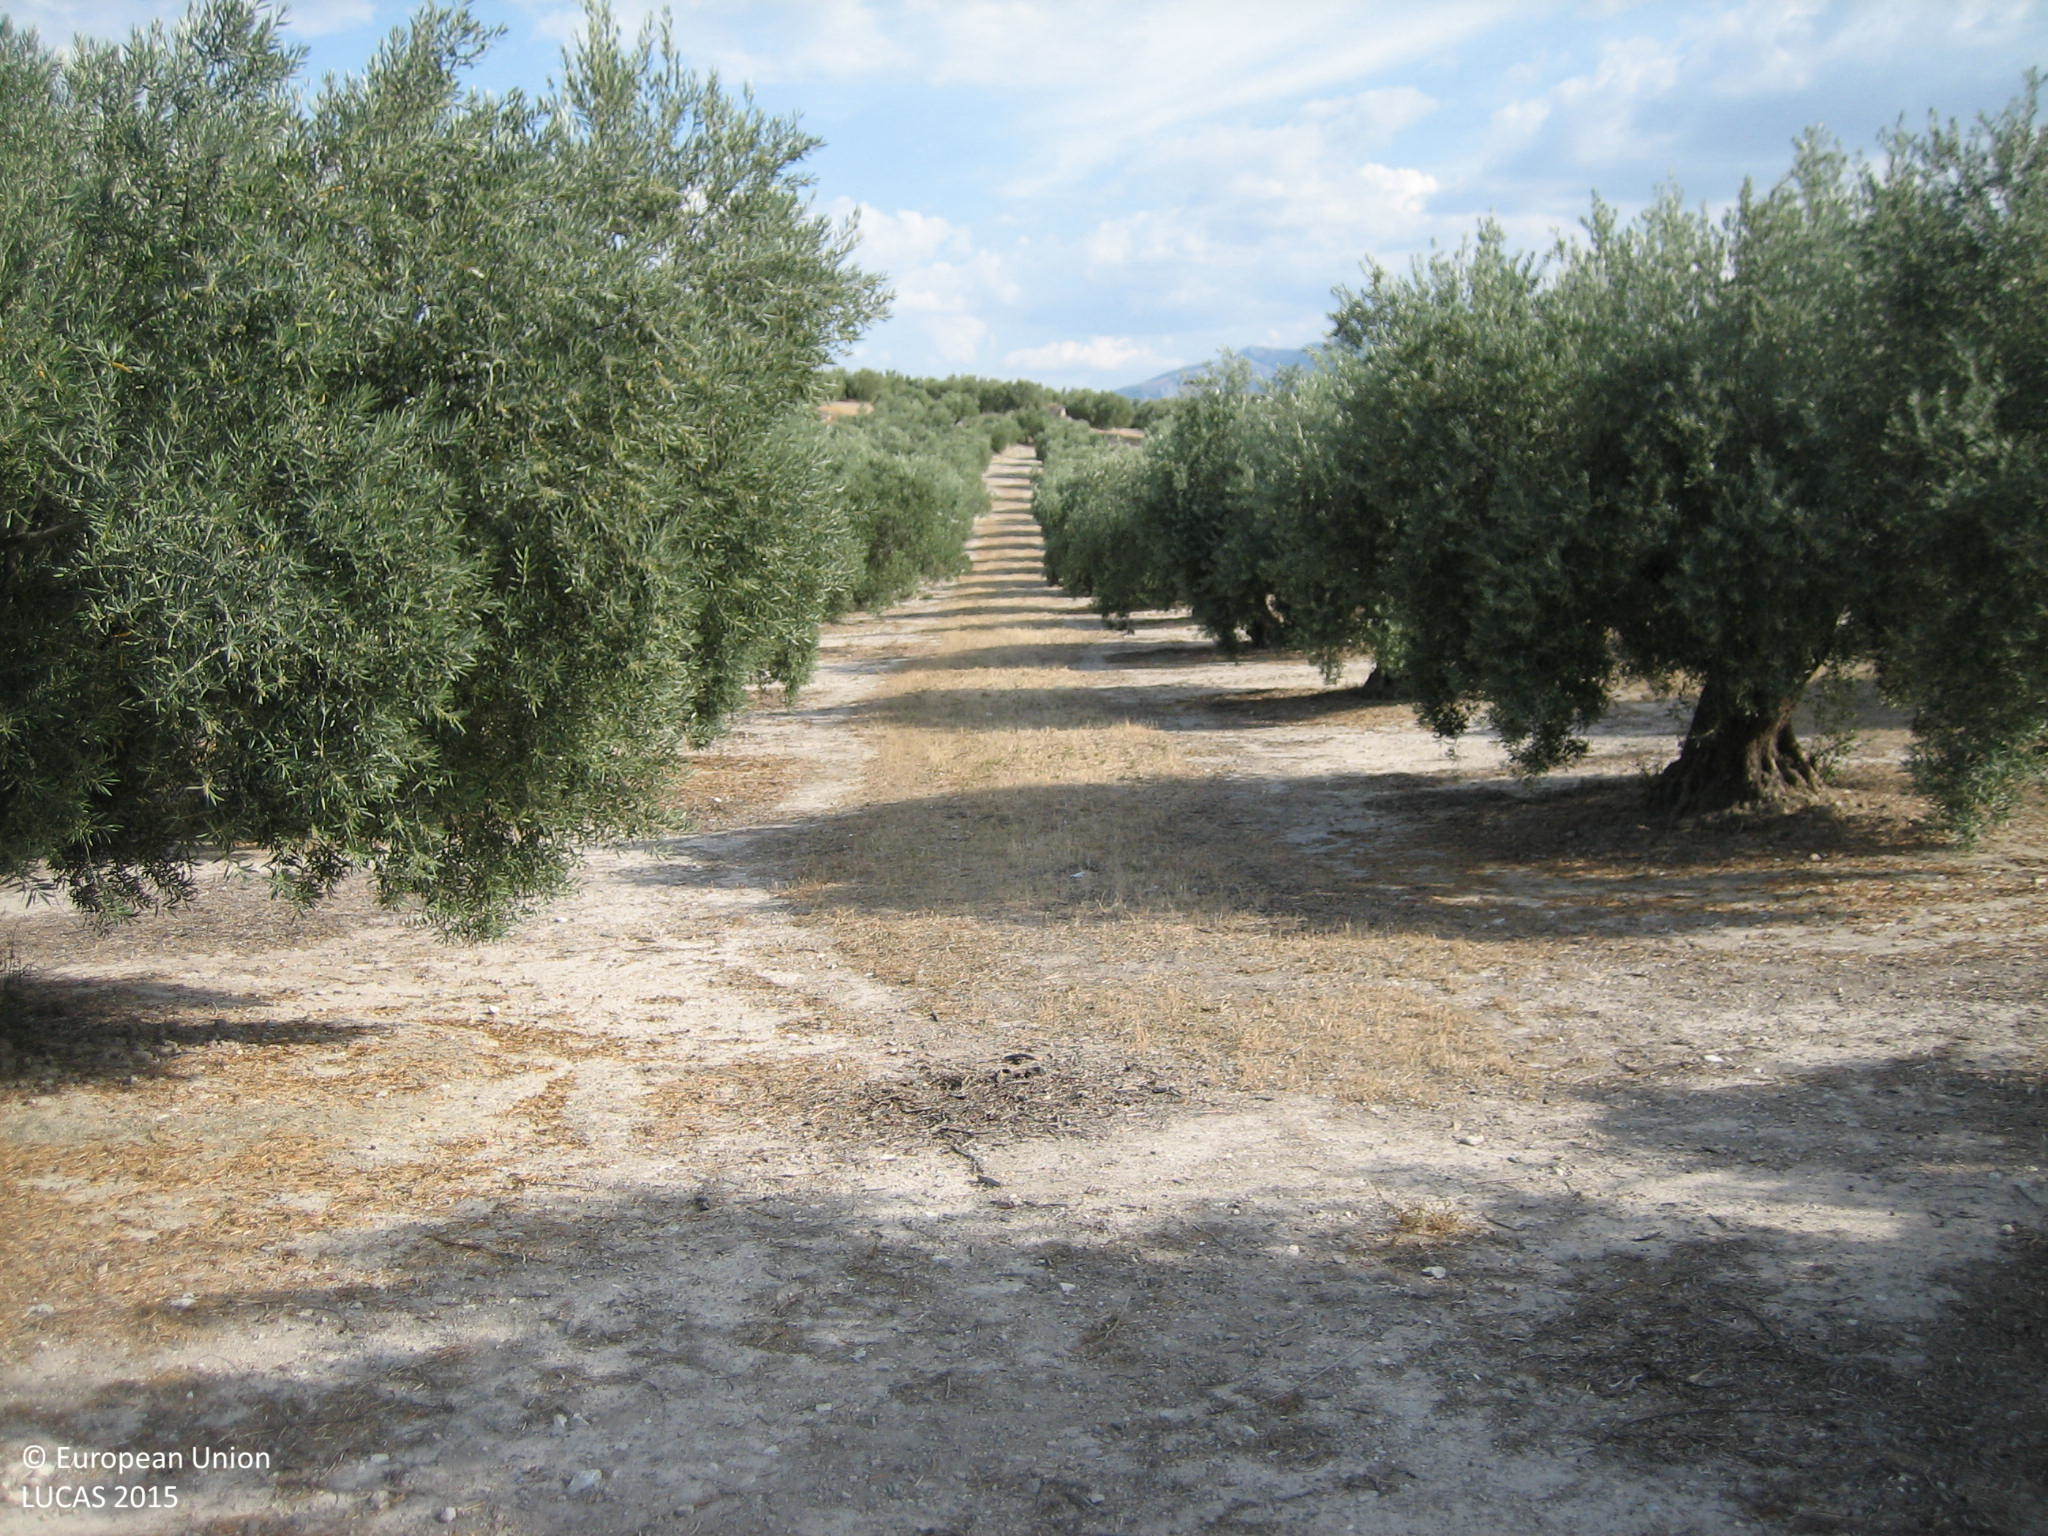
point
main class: Cropland
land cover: Olive groves
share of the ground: 25 - 50 %
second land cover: Other bare soil
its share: > 75 %
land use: Agriculture (excluding fallow land and kitchen gardens)
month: June
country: ES
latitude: 37.7688
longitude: -3.7708
